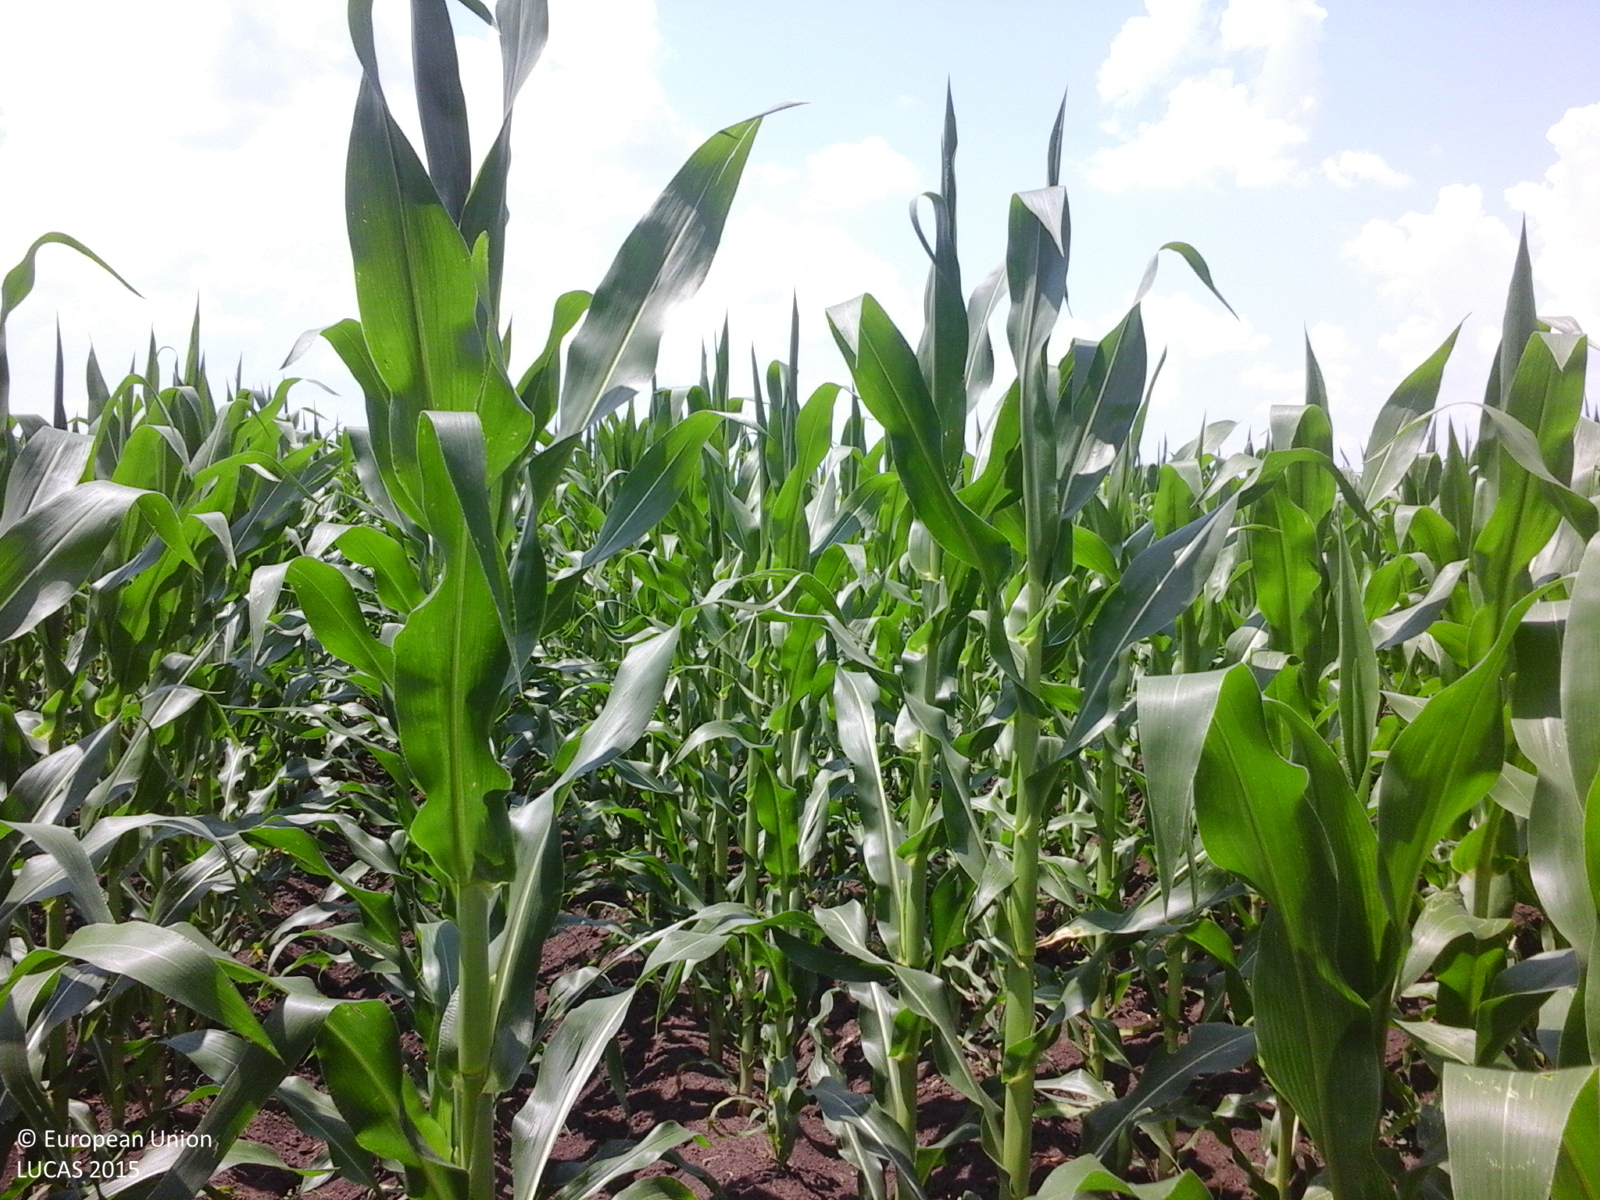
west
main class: Cropland
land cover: Maize
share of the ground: > 75 %
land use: Agriculture (excluding fallow land and kitchen gardens)
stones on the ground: < 10 %
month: July
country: RO
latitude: 43.9867
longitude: 25.4844
